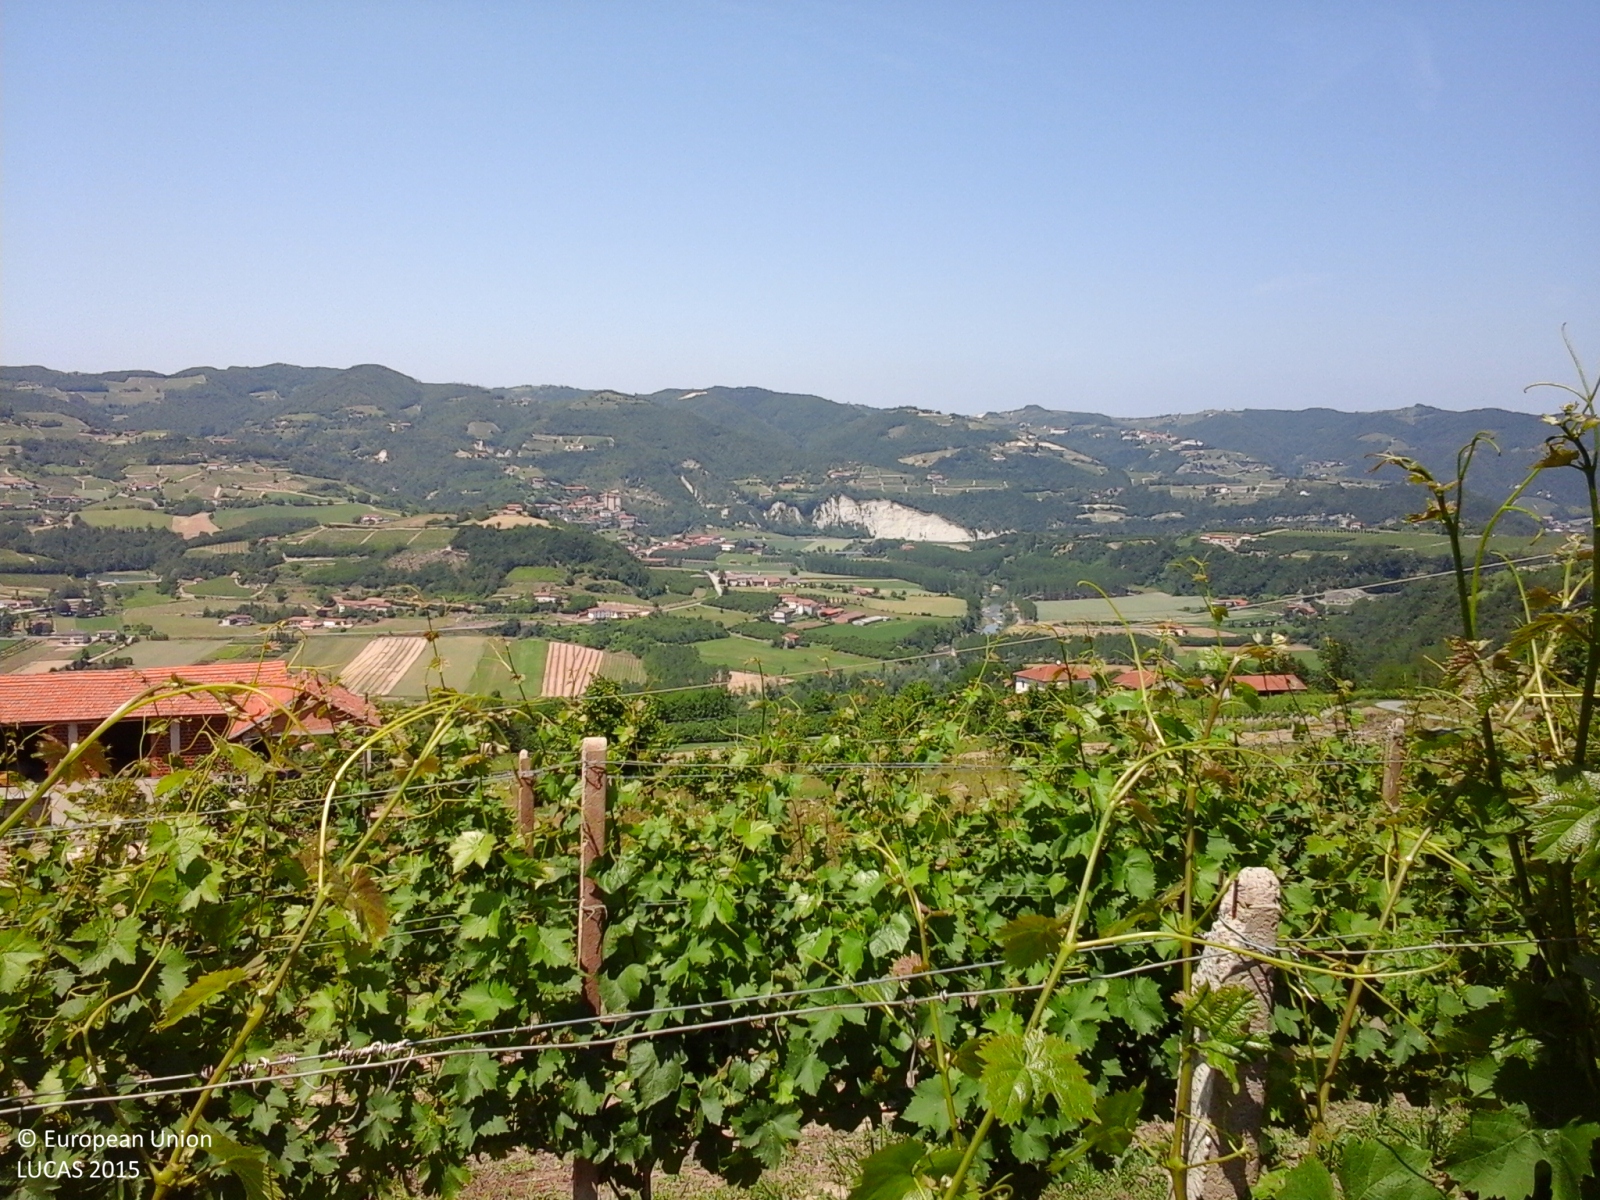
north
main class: Cropland
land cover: Vineyards
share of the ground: 50 - 75 %
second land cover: Grassland without tree/shrub cover
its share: > 75 %
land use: Agriculture (excluding fallow land and kitchen gardens)
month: June
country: IT
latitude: 44.6245
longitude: 8.2517
